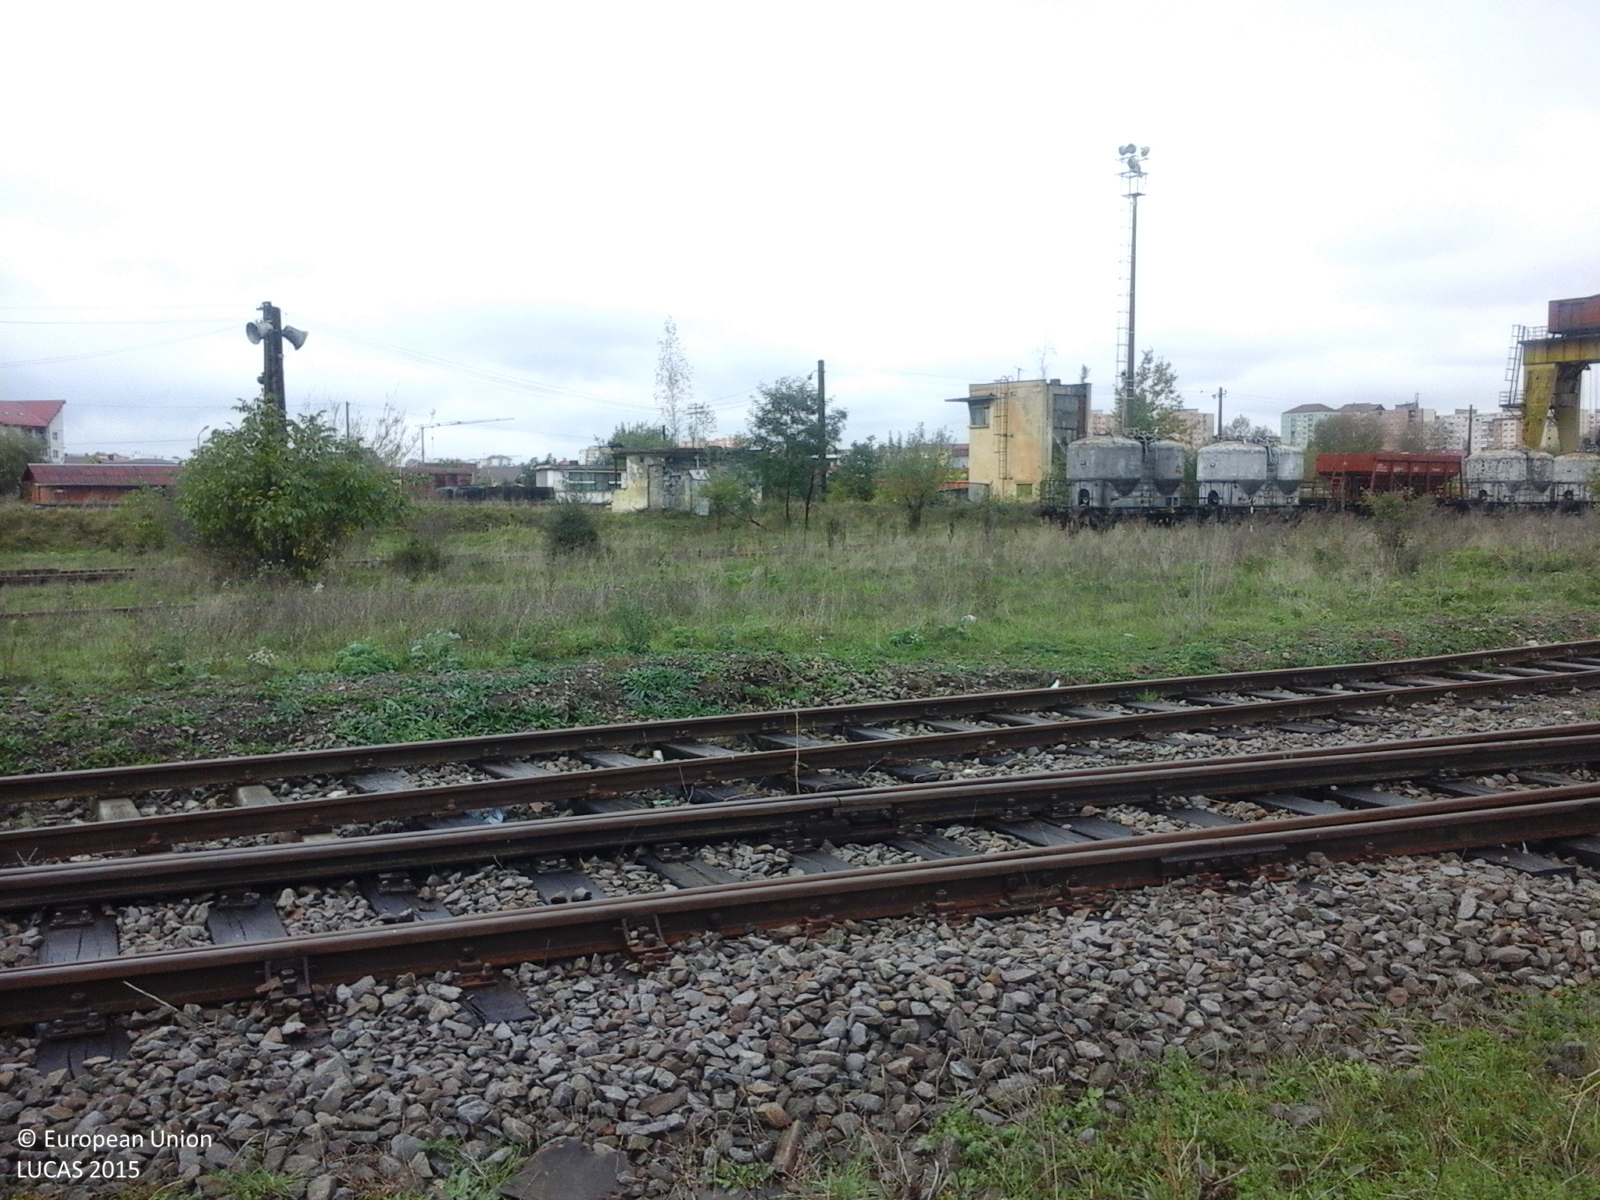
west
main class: Grassland
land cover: Spontaneously vegetated surfaces
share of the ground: > 75 %
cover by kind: herbaceous plants 100 %
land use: Railway transport
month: October
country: RO
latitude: 45.7837
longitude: 24.1855
